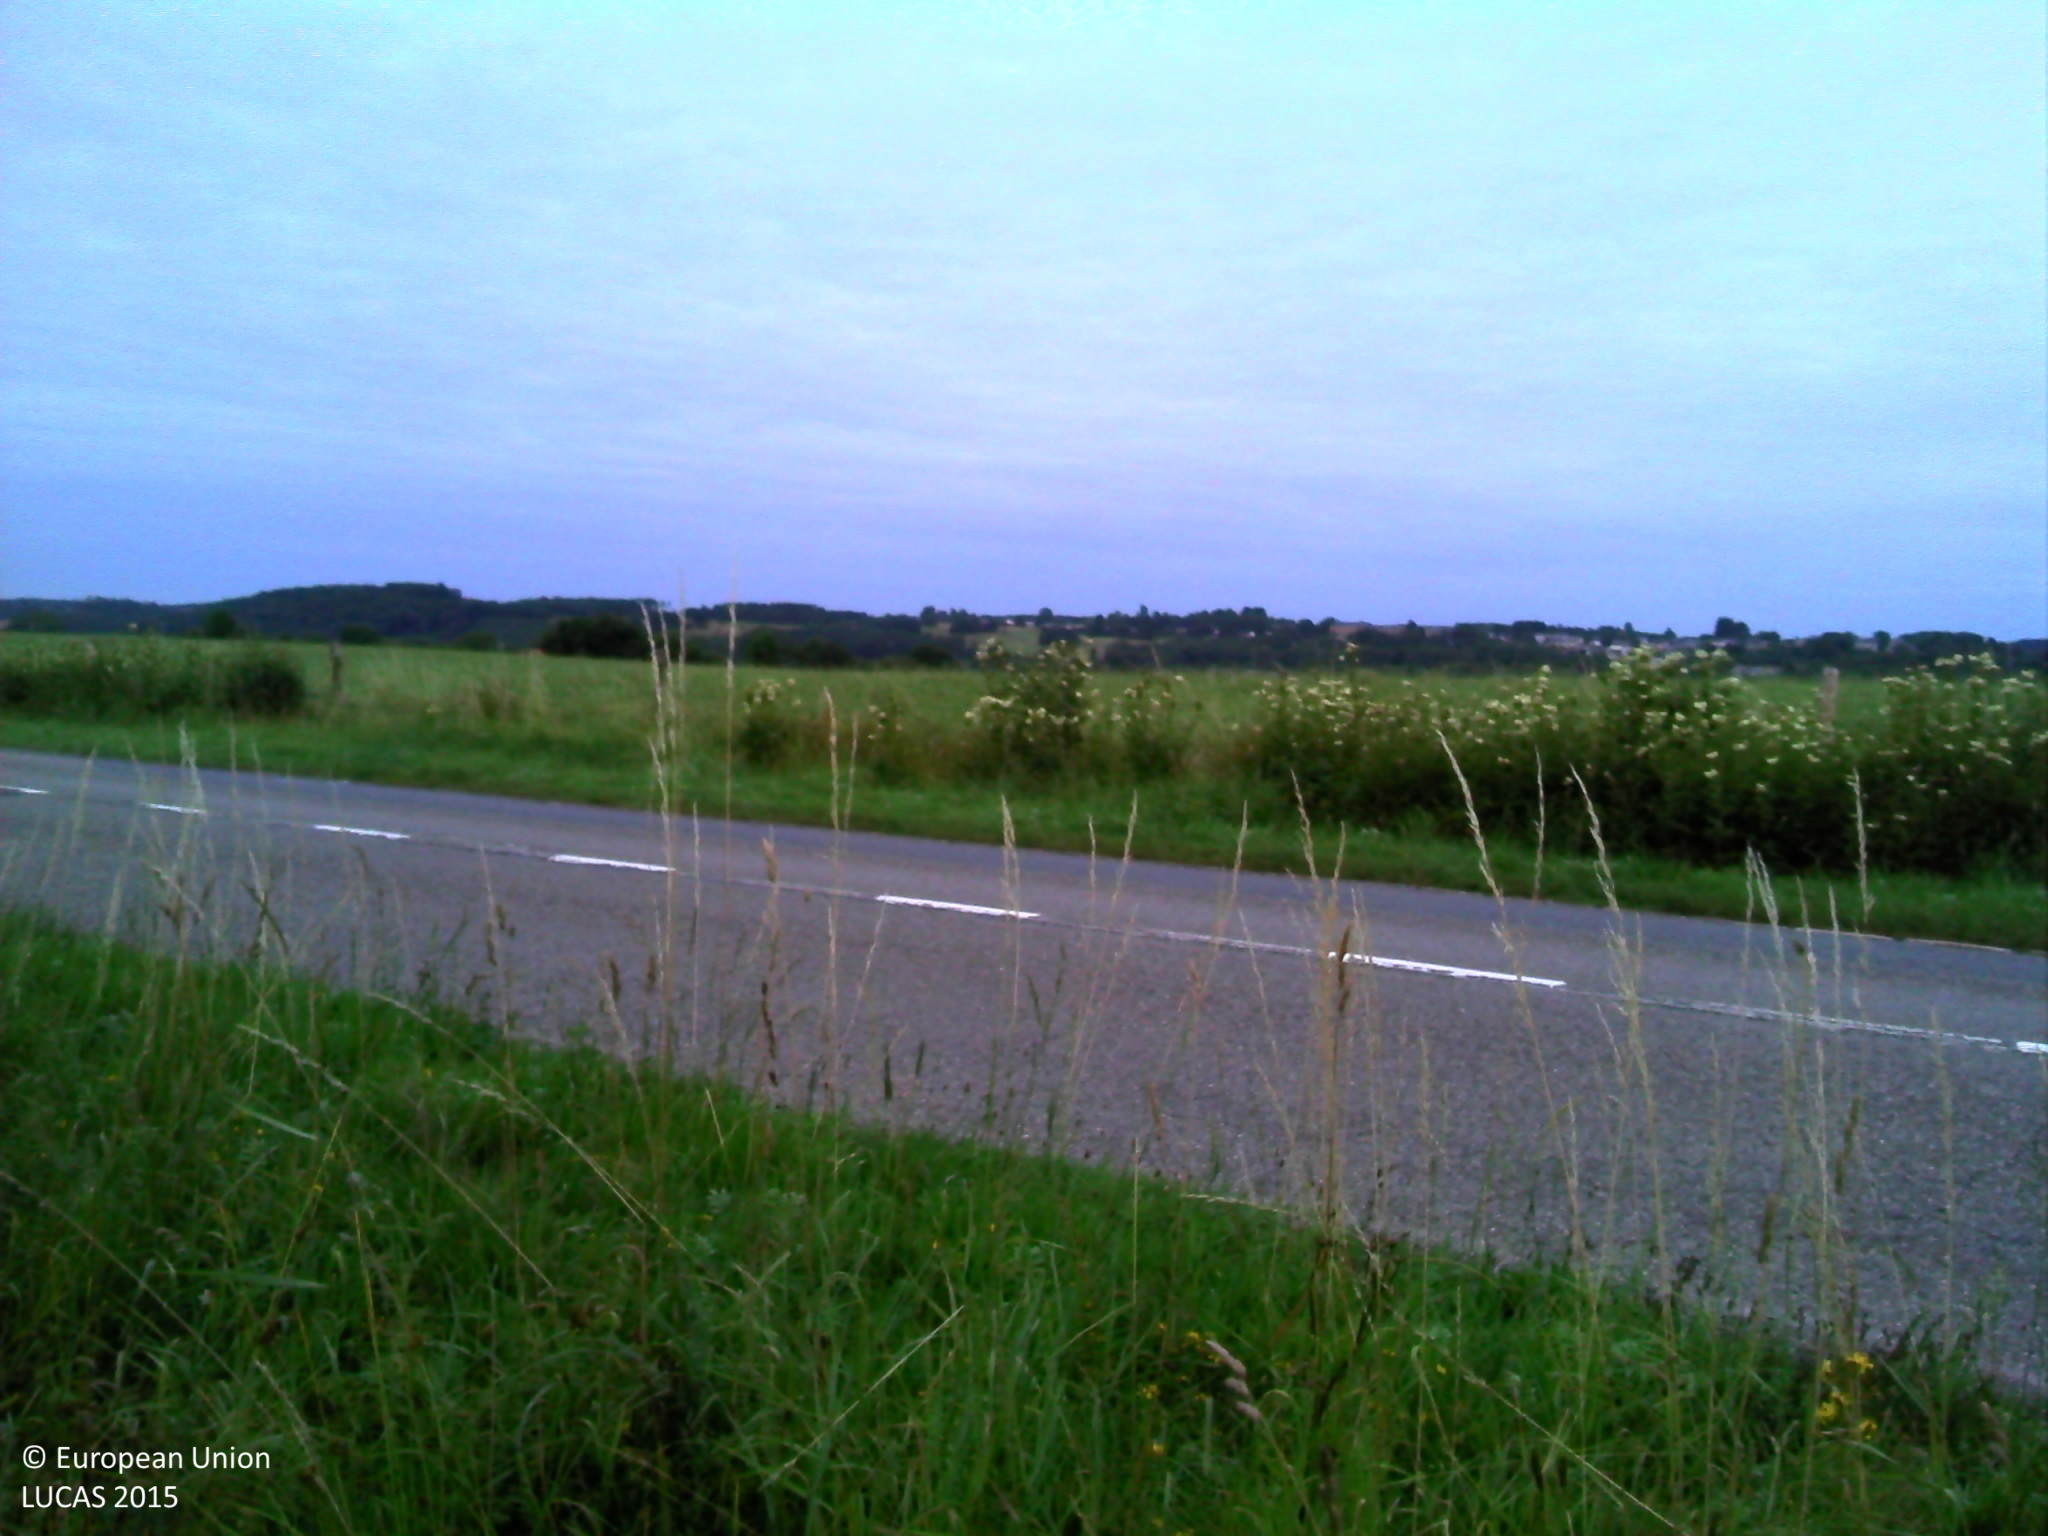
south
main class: Grassland
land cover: Grassland without tree/shrub cover
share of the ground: > 75 %
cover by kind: herbaceous plants 100 %
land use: Agriculture (excluding fallow land and kitchen gardens)
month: July
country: BE
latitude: 49.7124
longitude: 5.3801
